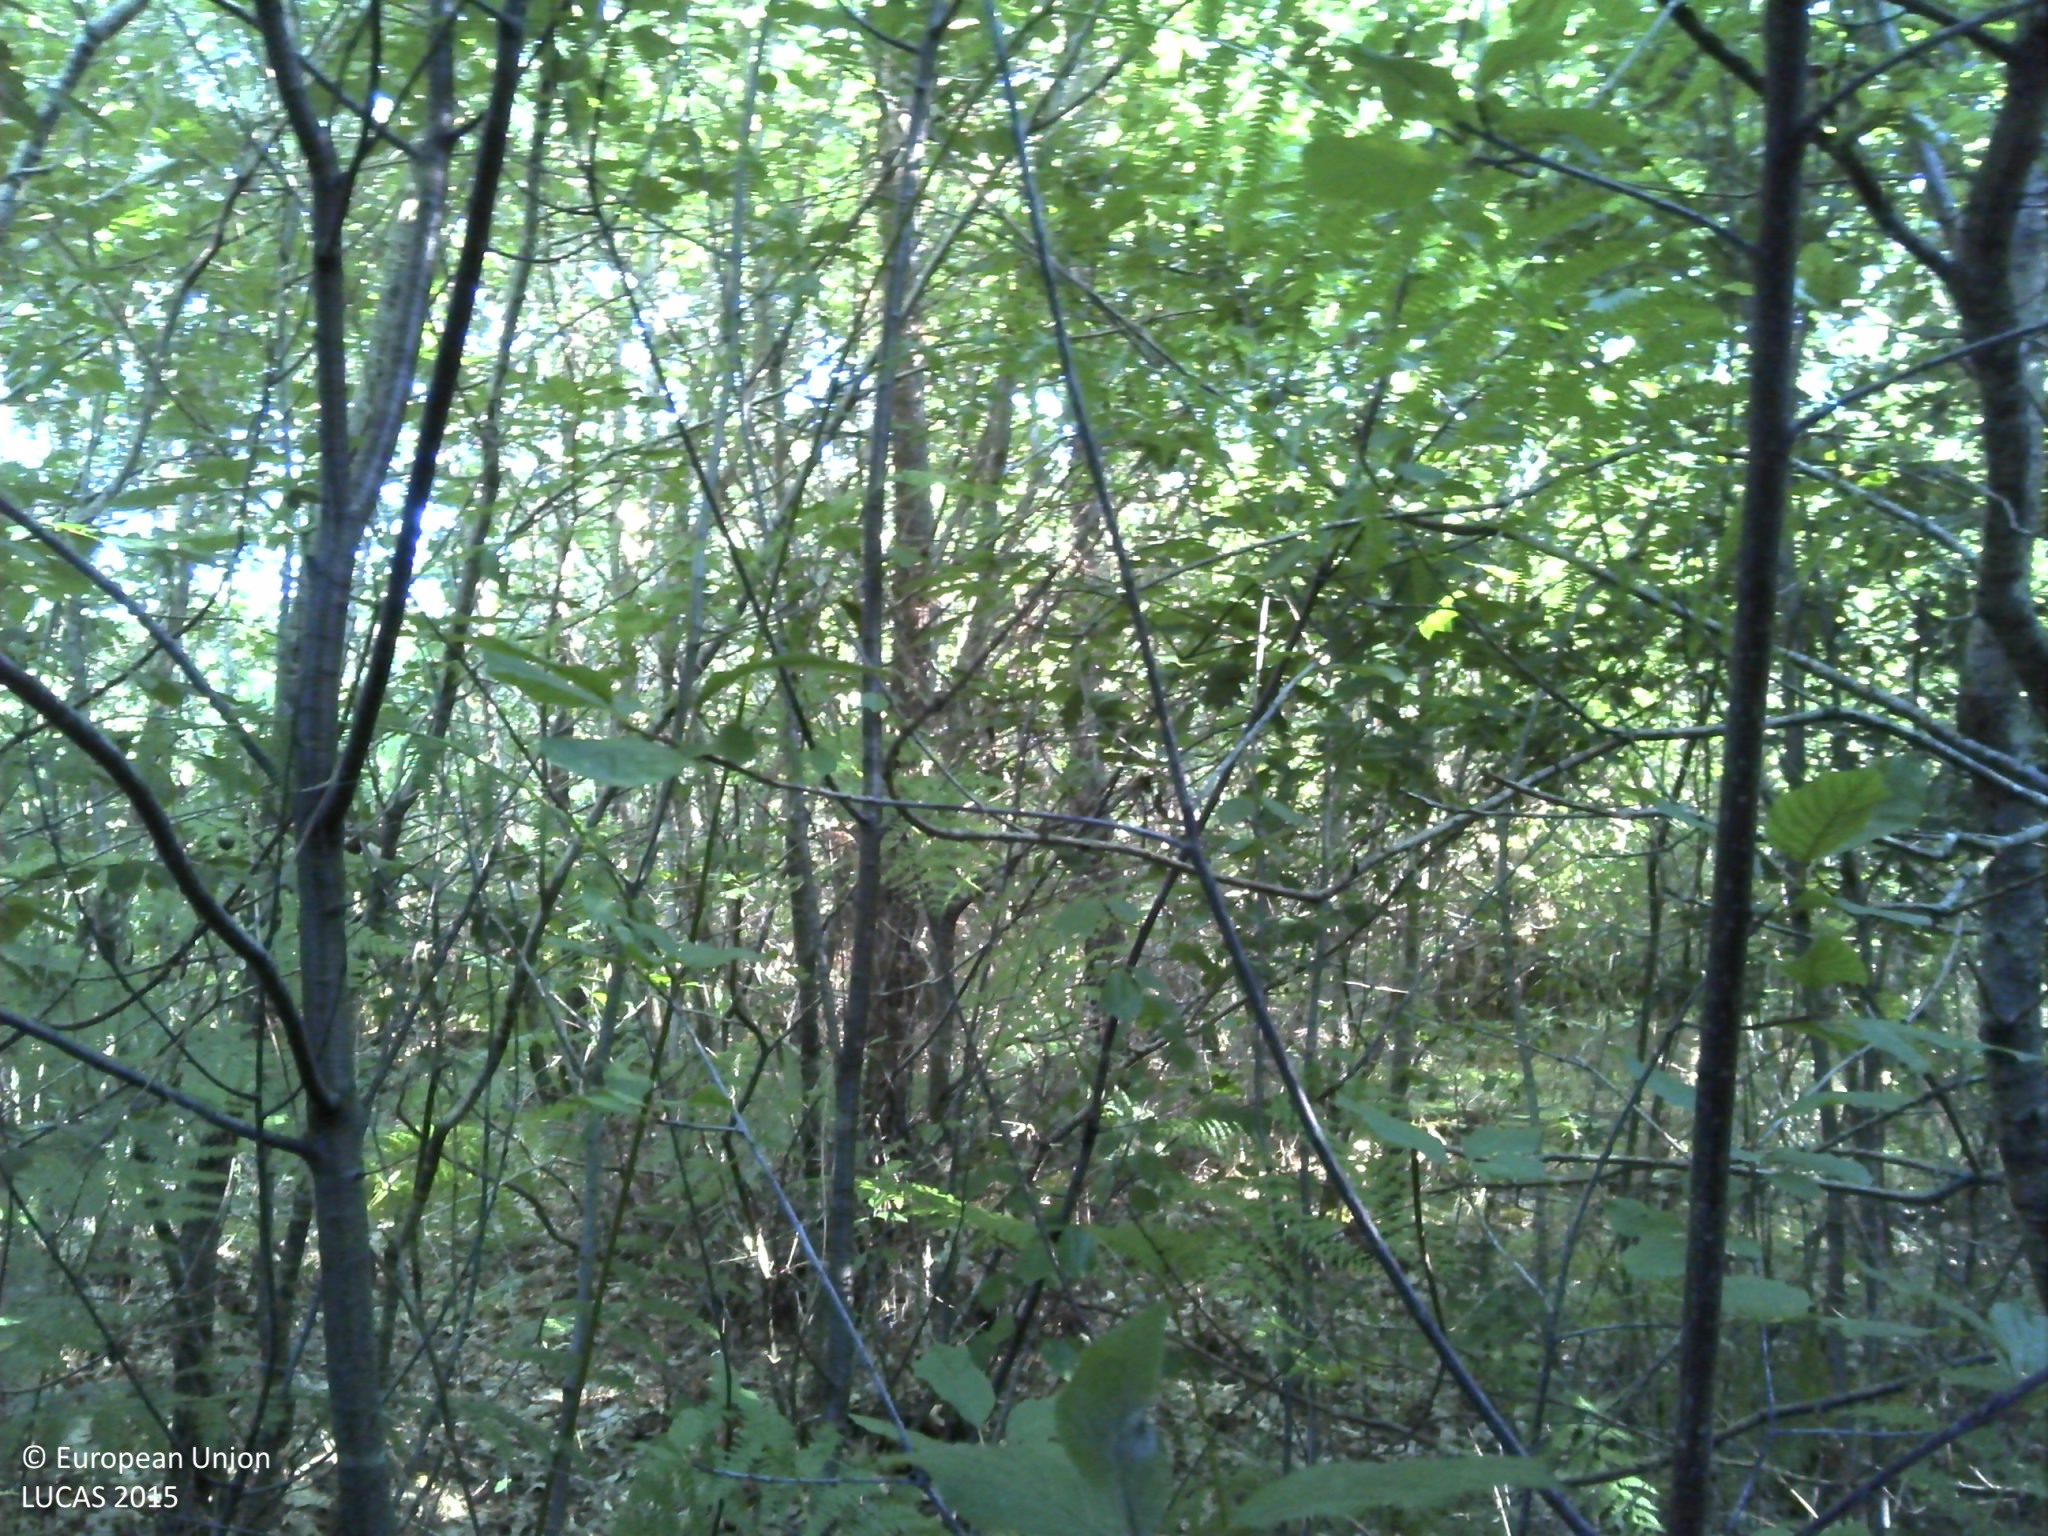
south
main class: Woodland
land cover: Pine dominated mixed woodland
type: coniferous forest of the mediterranean region
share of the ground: > 75 %
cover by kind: coniferous forest trees 50 %, broadleaved forest trees 25 %, shrubs 25 %
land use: Forestry
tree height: > 5 m
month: July
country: FR
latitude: 44.9635
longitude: -0.6567
